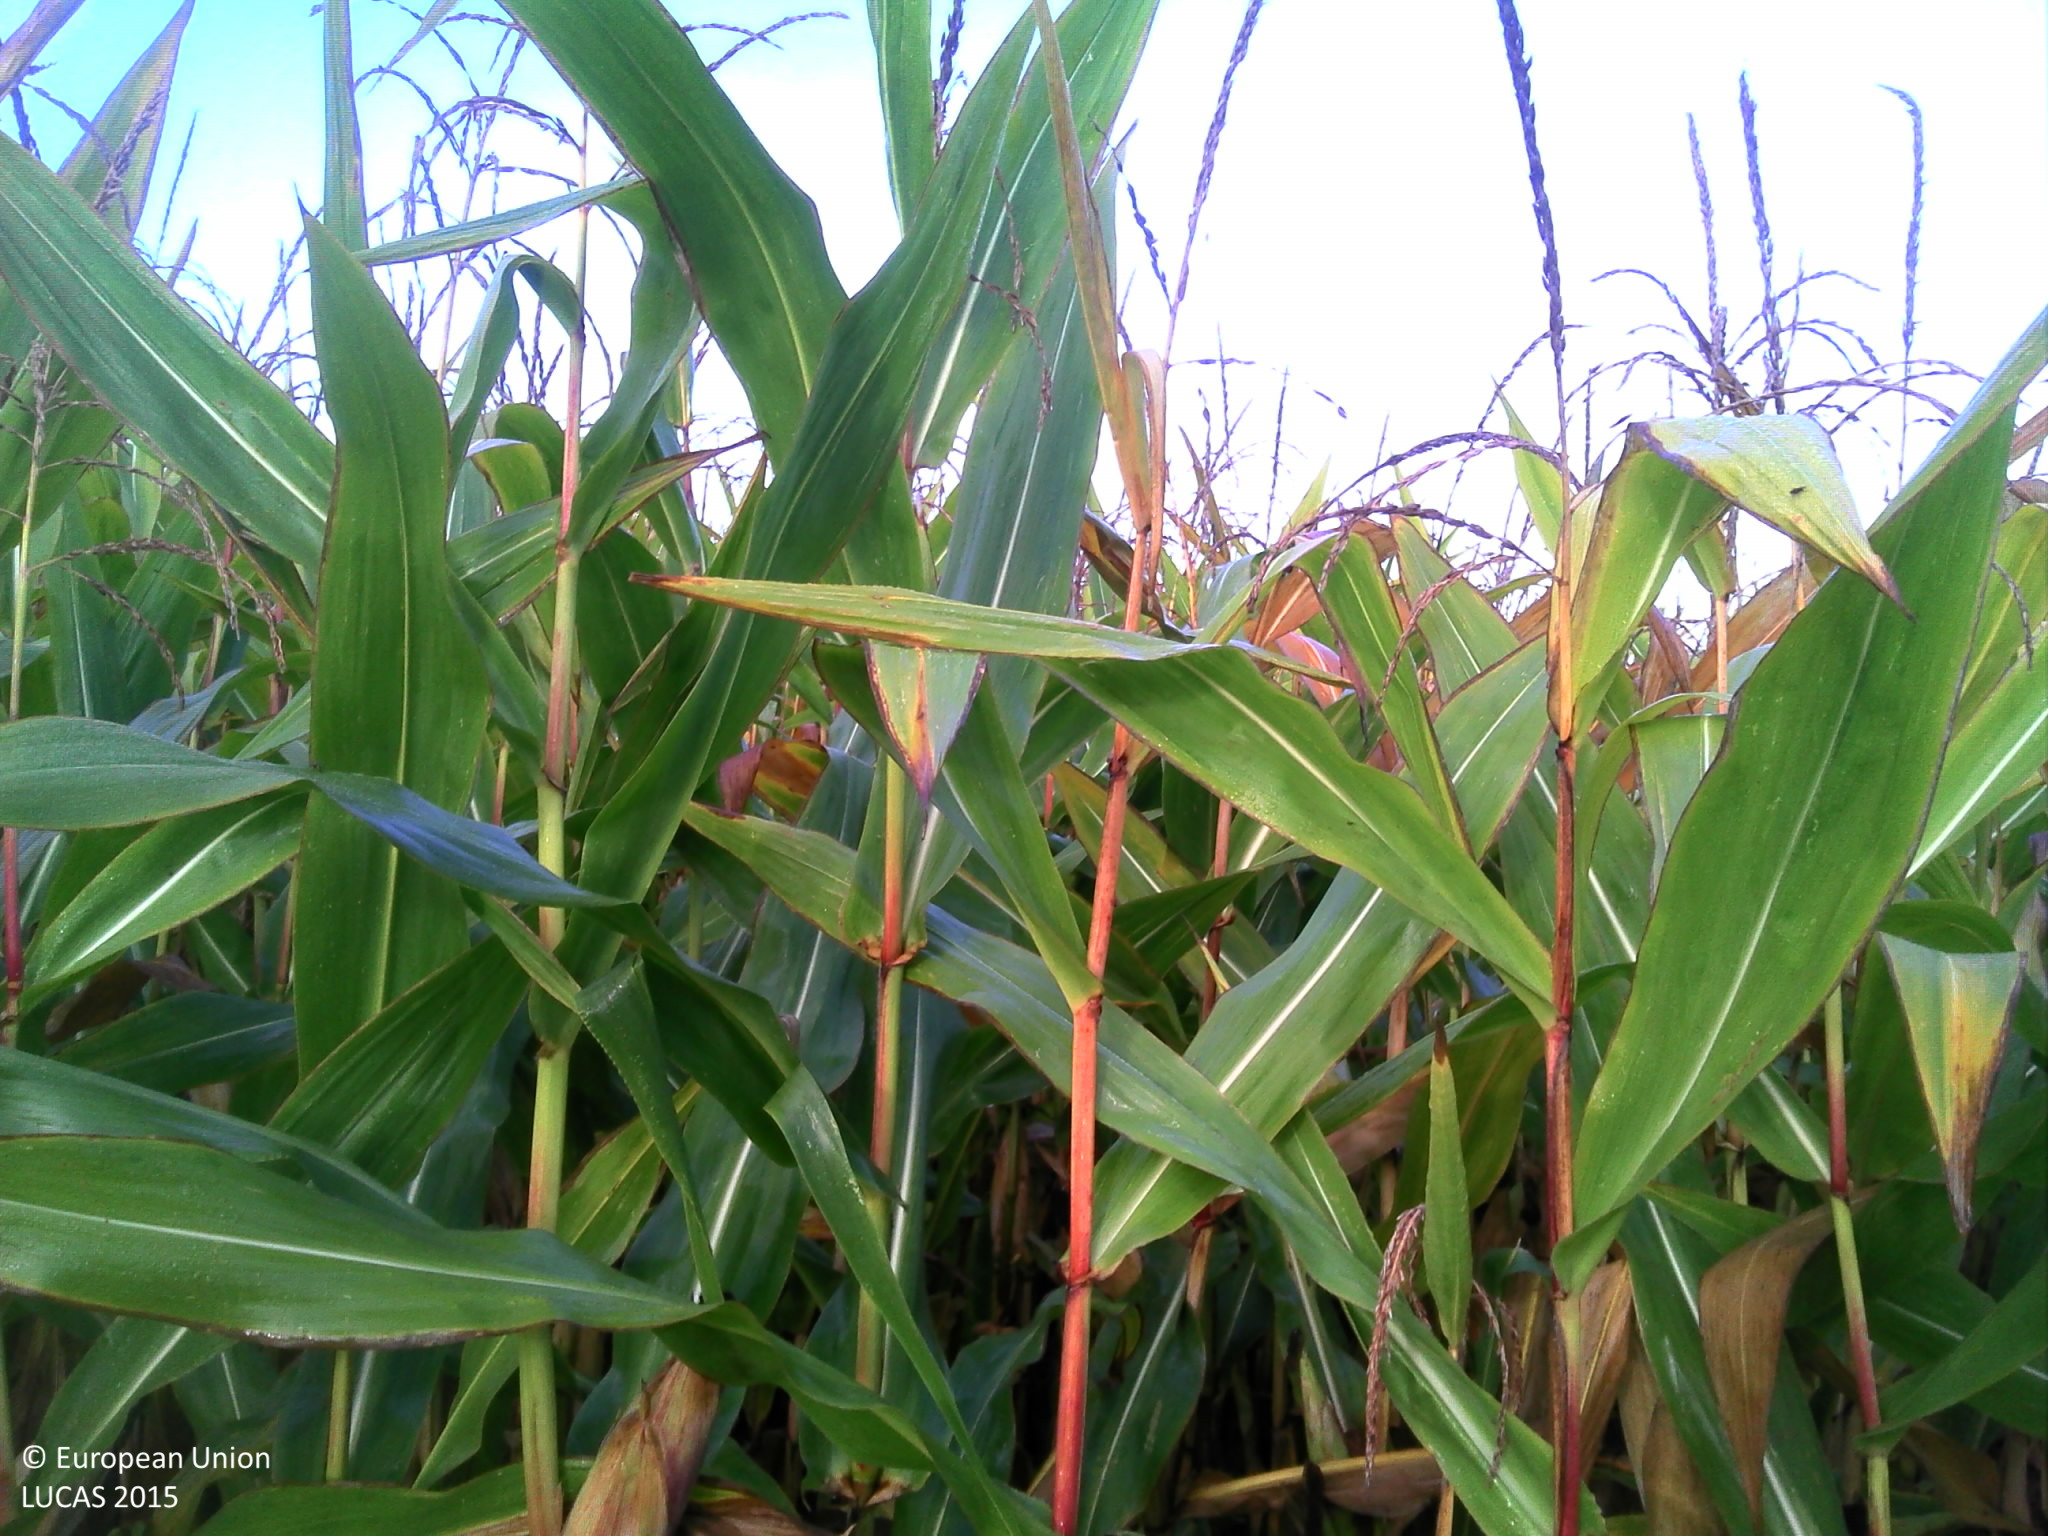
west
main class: Cropland
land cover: Maize
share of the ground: > 75 %
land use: Agriculture (excluding fallow land and kitchen gardens)
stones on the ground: < 10 %
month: September
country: BE
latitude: 51.0747
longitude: 4.4149
